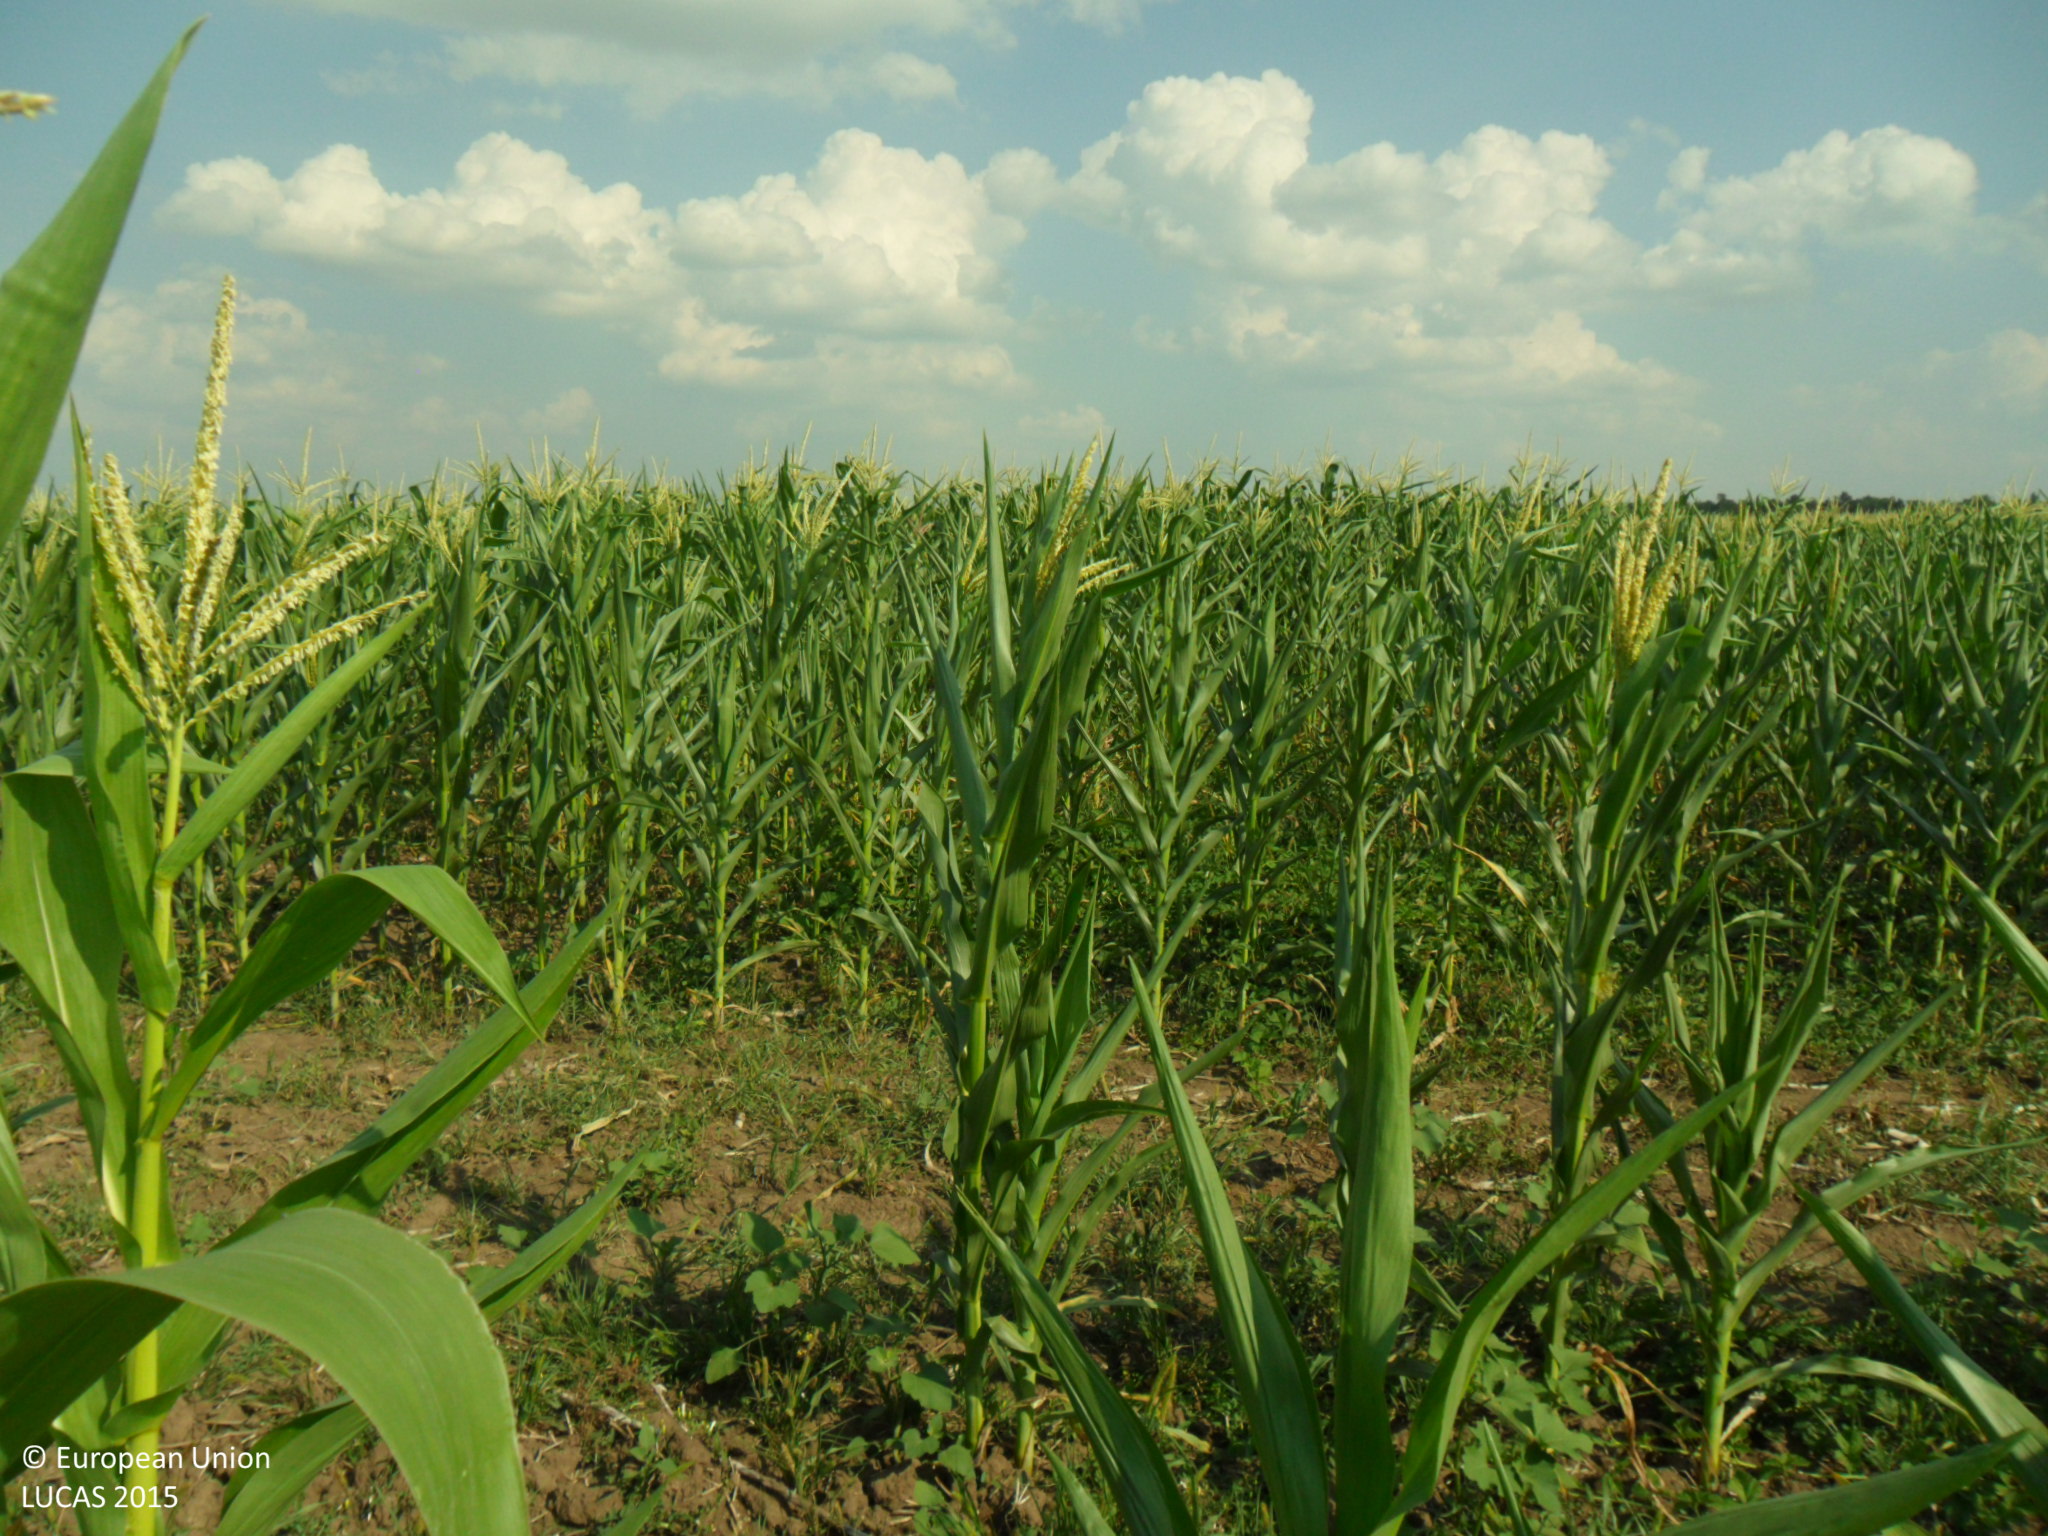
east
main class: Cropland
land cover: Maize
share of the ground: > 75 %
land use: Agriculture (excluding fallow land and kitchen gardens)
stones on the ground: < 10 %
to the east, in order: Maize; Tracks; Common wheat; Grass margins; Other fresh vegetables; Grass margins; Common wheat
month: July
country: BG
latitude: 43.6457
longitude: 27.0427
